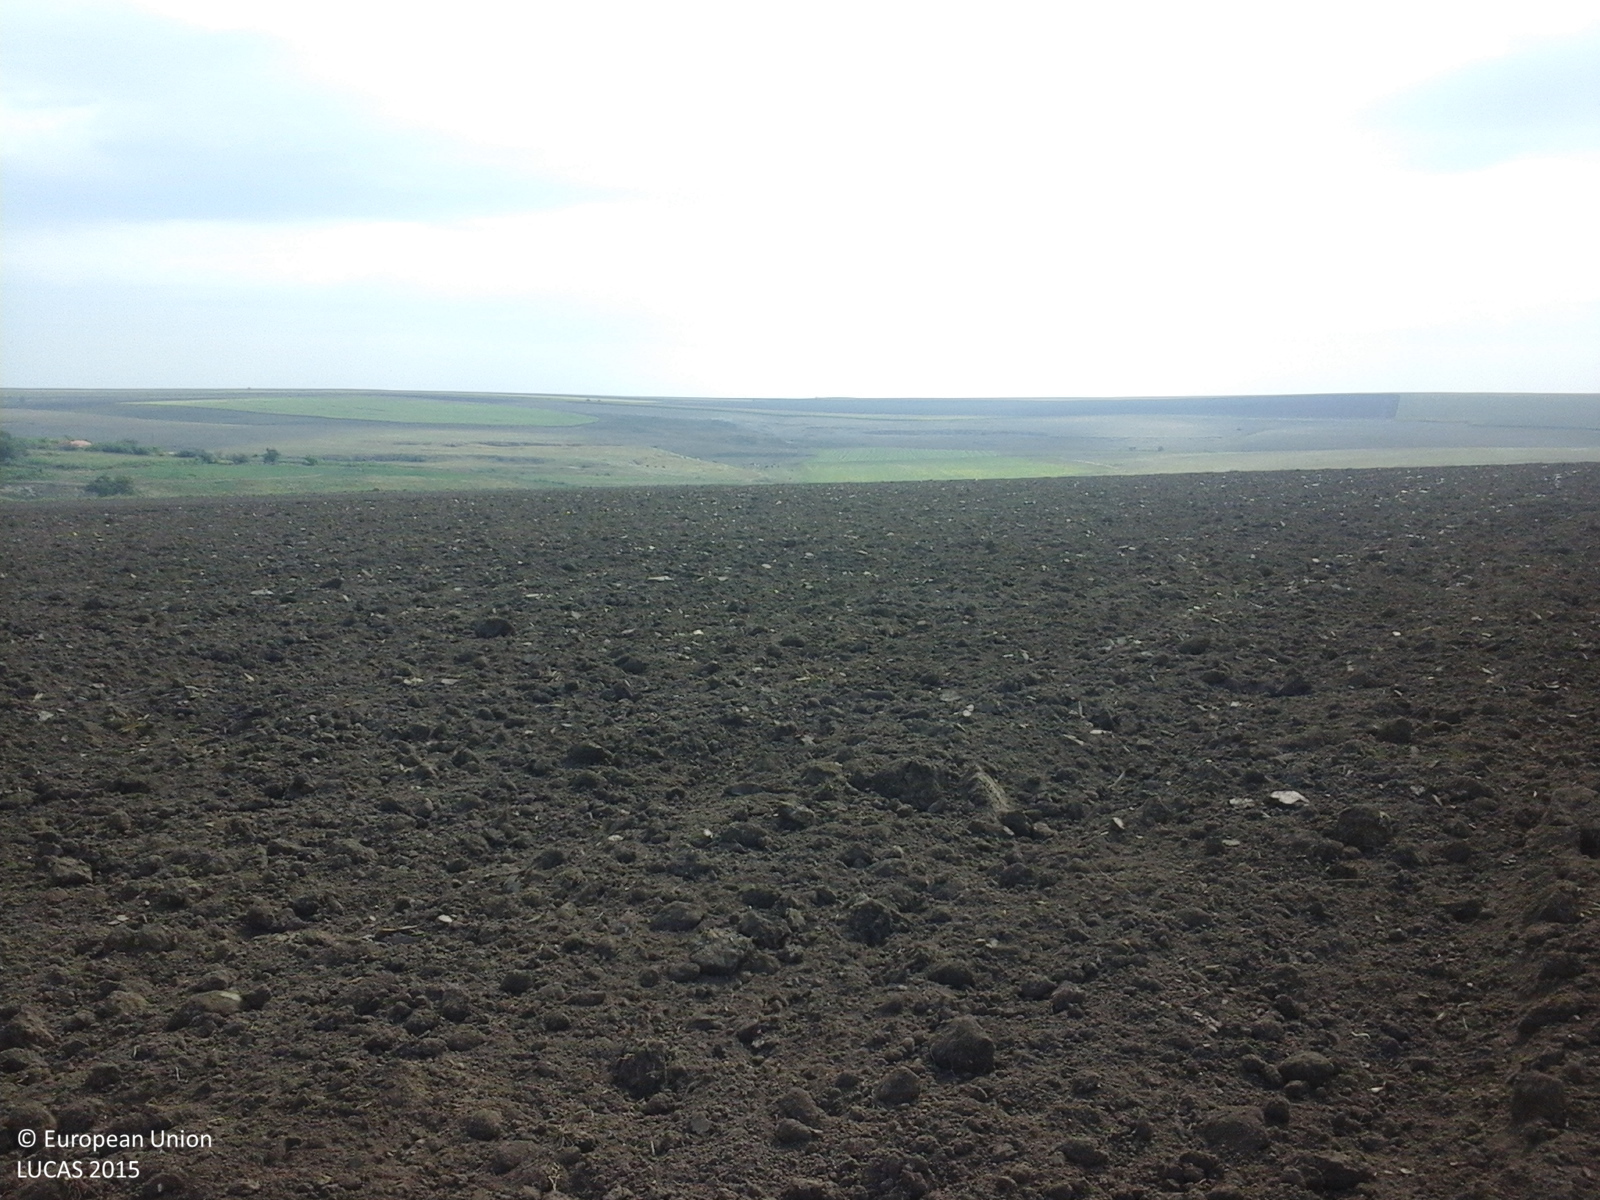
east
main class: Cropland
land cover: Common wheat
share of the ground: < 10 %
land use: Agriculture (excluding fallow land and kitchen gardens)
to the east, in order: Common wheat
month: August
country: RO
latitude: 43.8140
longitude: 28.0919
